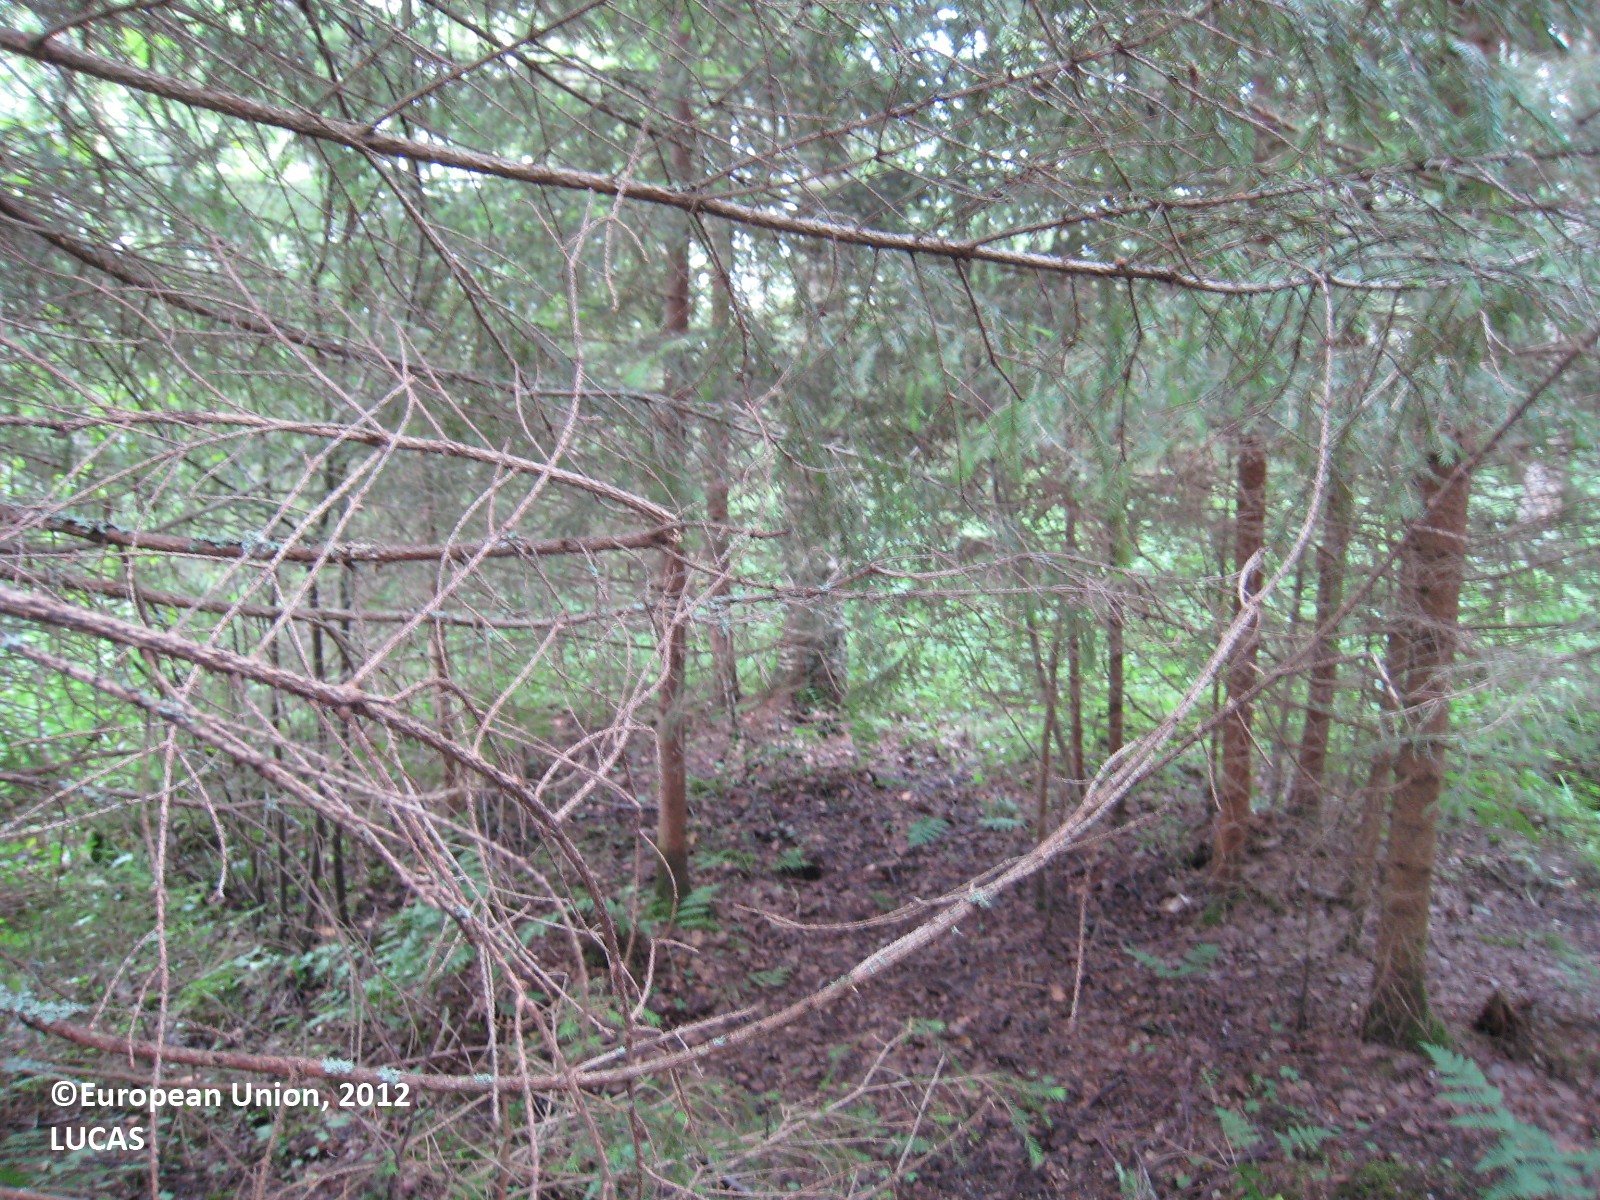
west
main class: Woodland
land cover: Spruce dominated mixed woodland
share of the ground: > 75 %
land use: Forestry
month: July
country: FI
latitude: 61.8981
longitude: 27.1177
